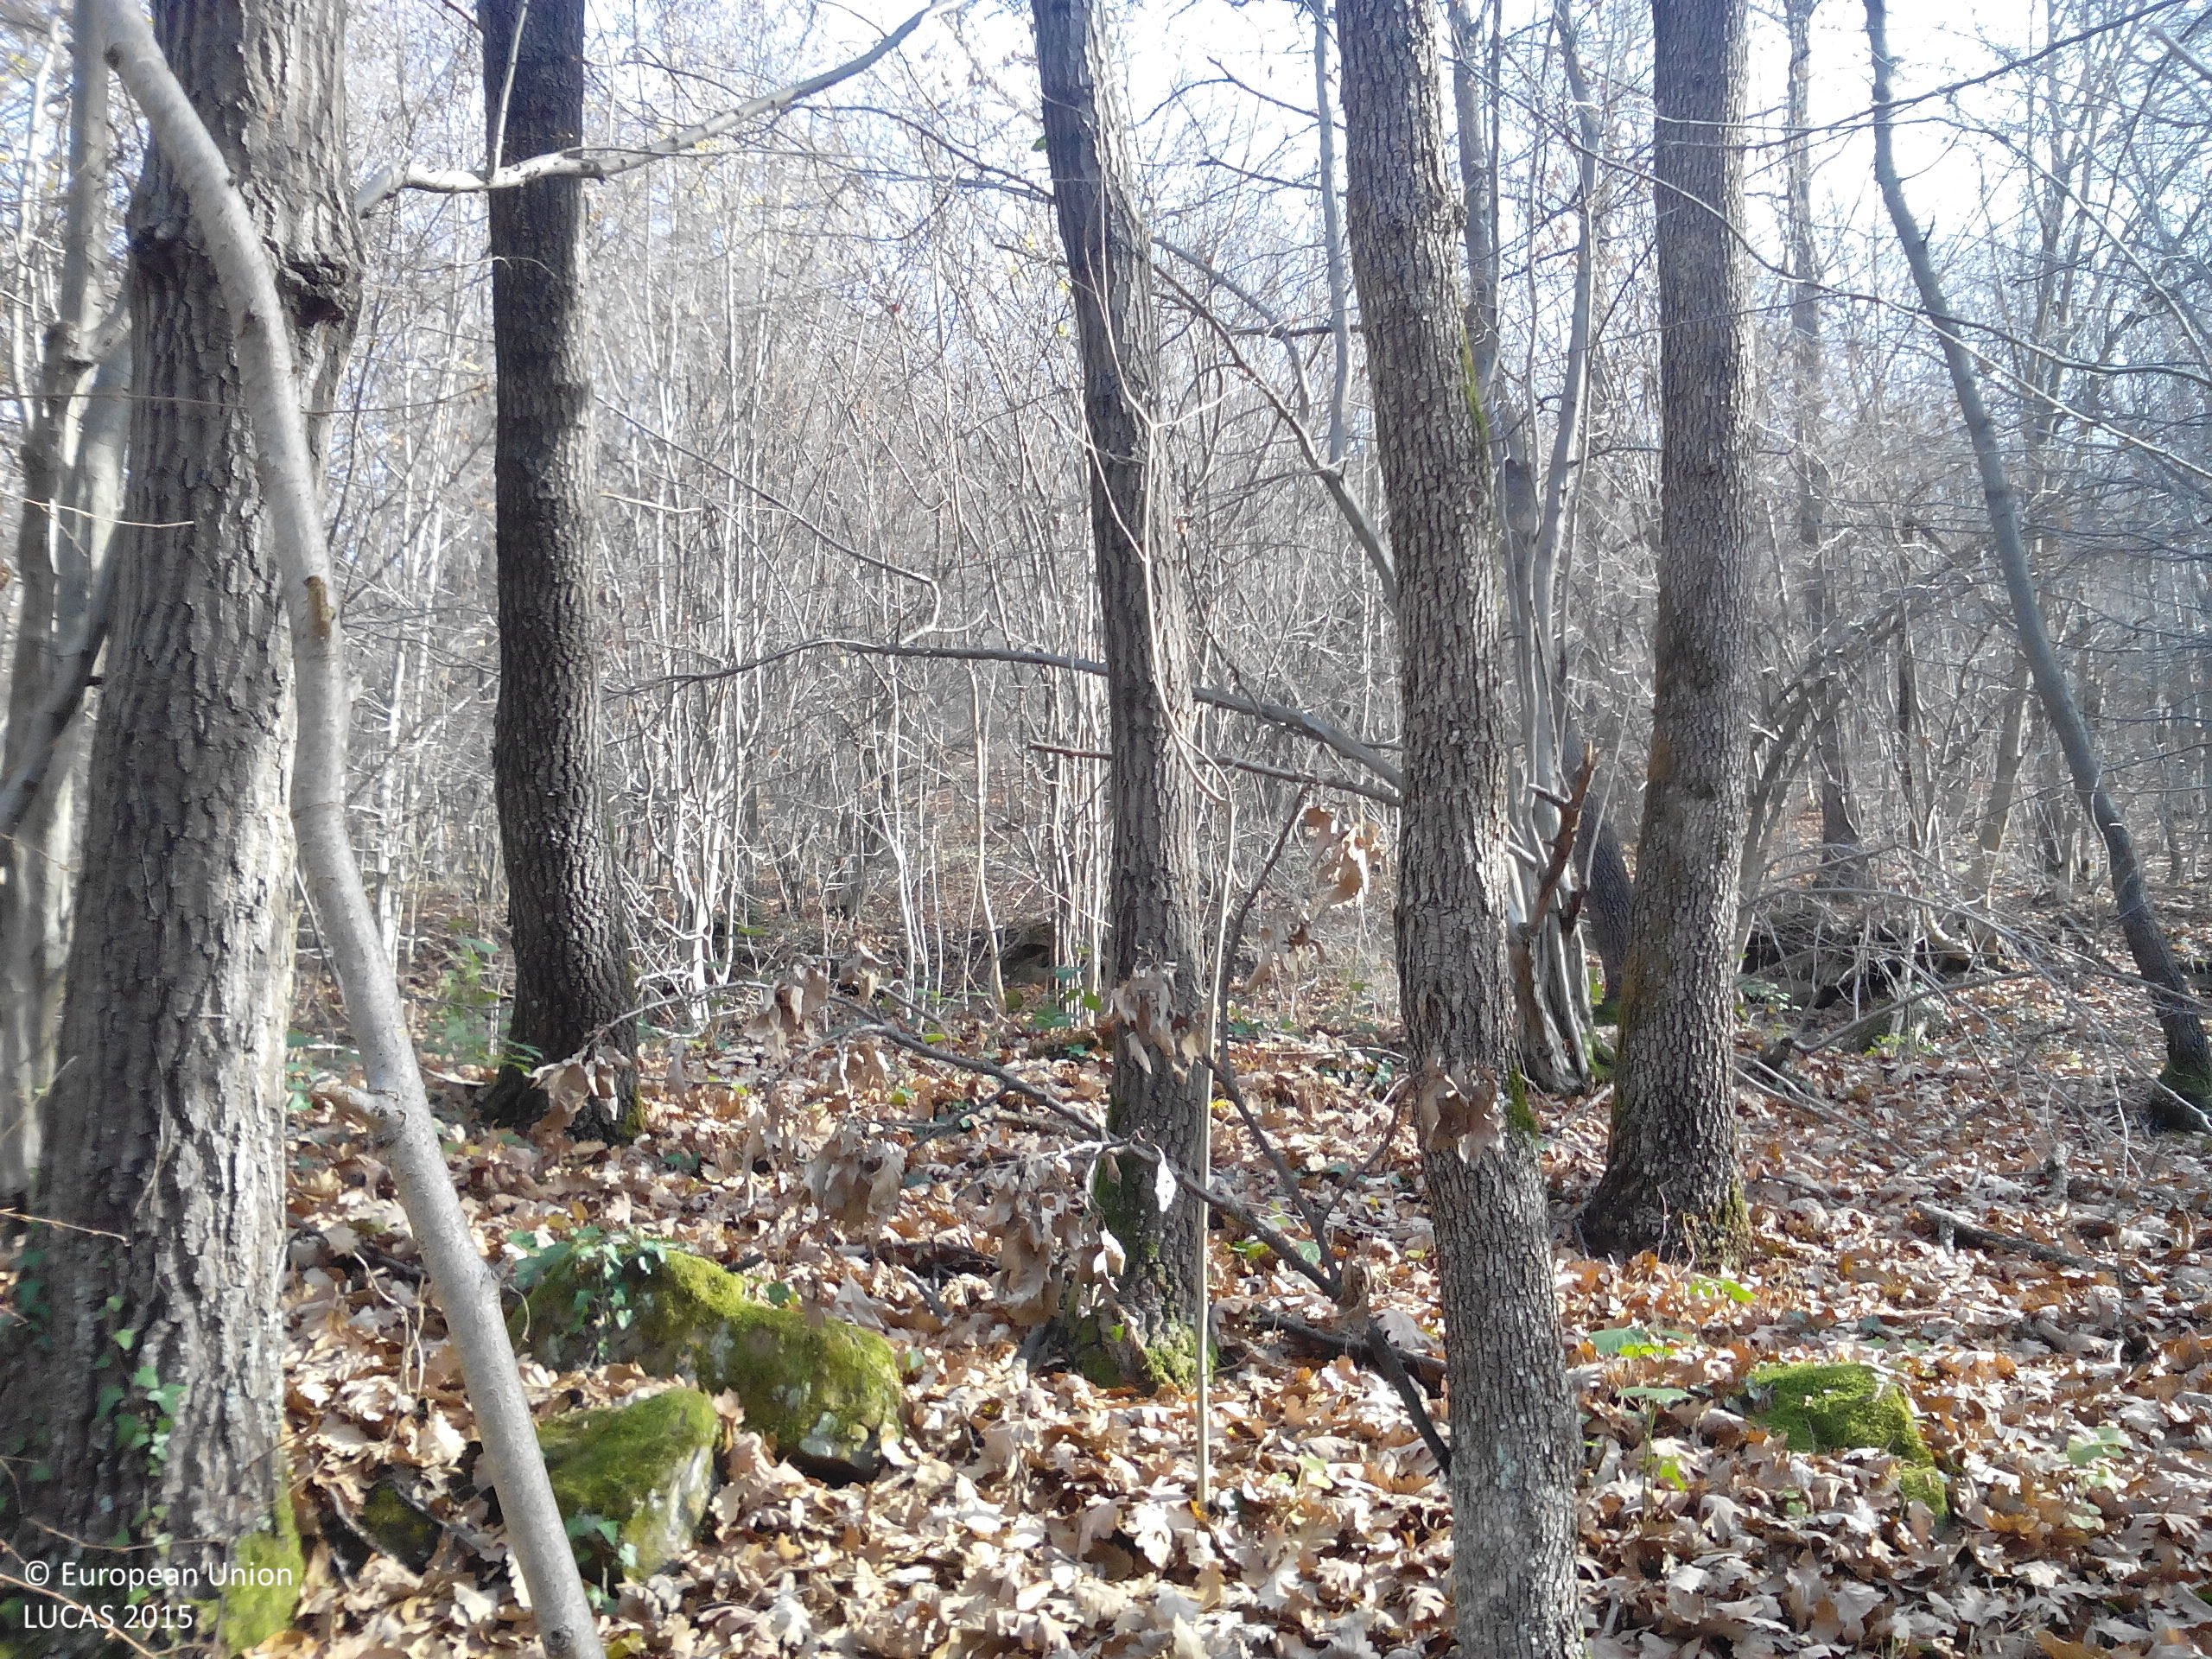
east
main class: Woodland
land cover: Broadleaved woodland
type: mesophytic deciduous forest
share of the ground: > 75 %
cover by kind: broadleaved forest trees 95 %, shrubs 5 %
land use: Forestry
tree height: > 5 m
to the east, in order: Broadleaved woodland; Tracks; Broadleaved woodland
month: November
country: BG
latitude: 43.1084
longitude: 23.6964
